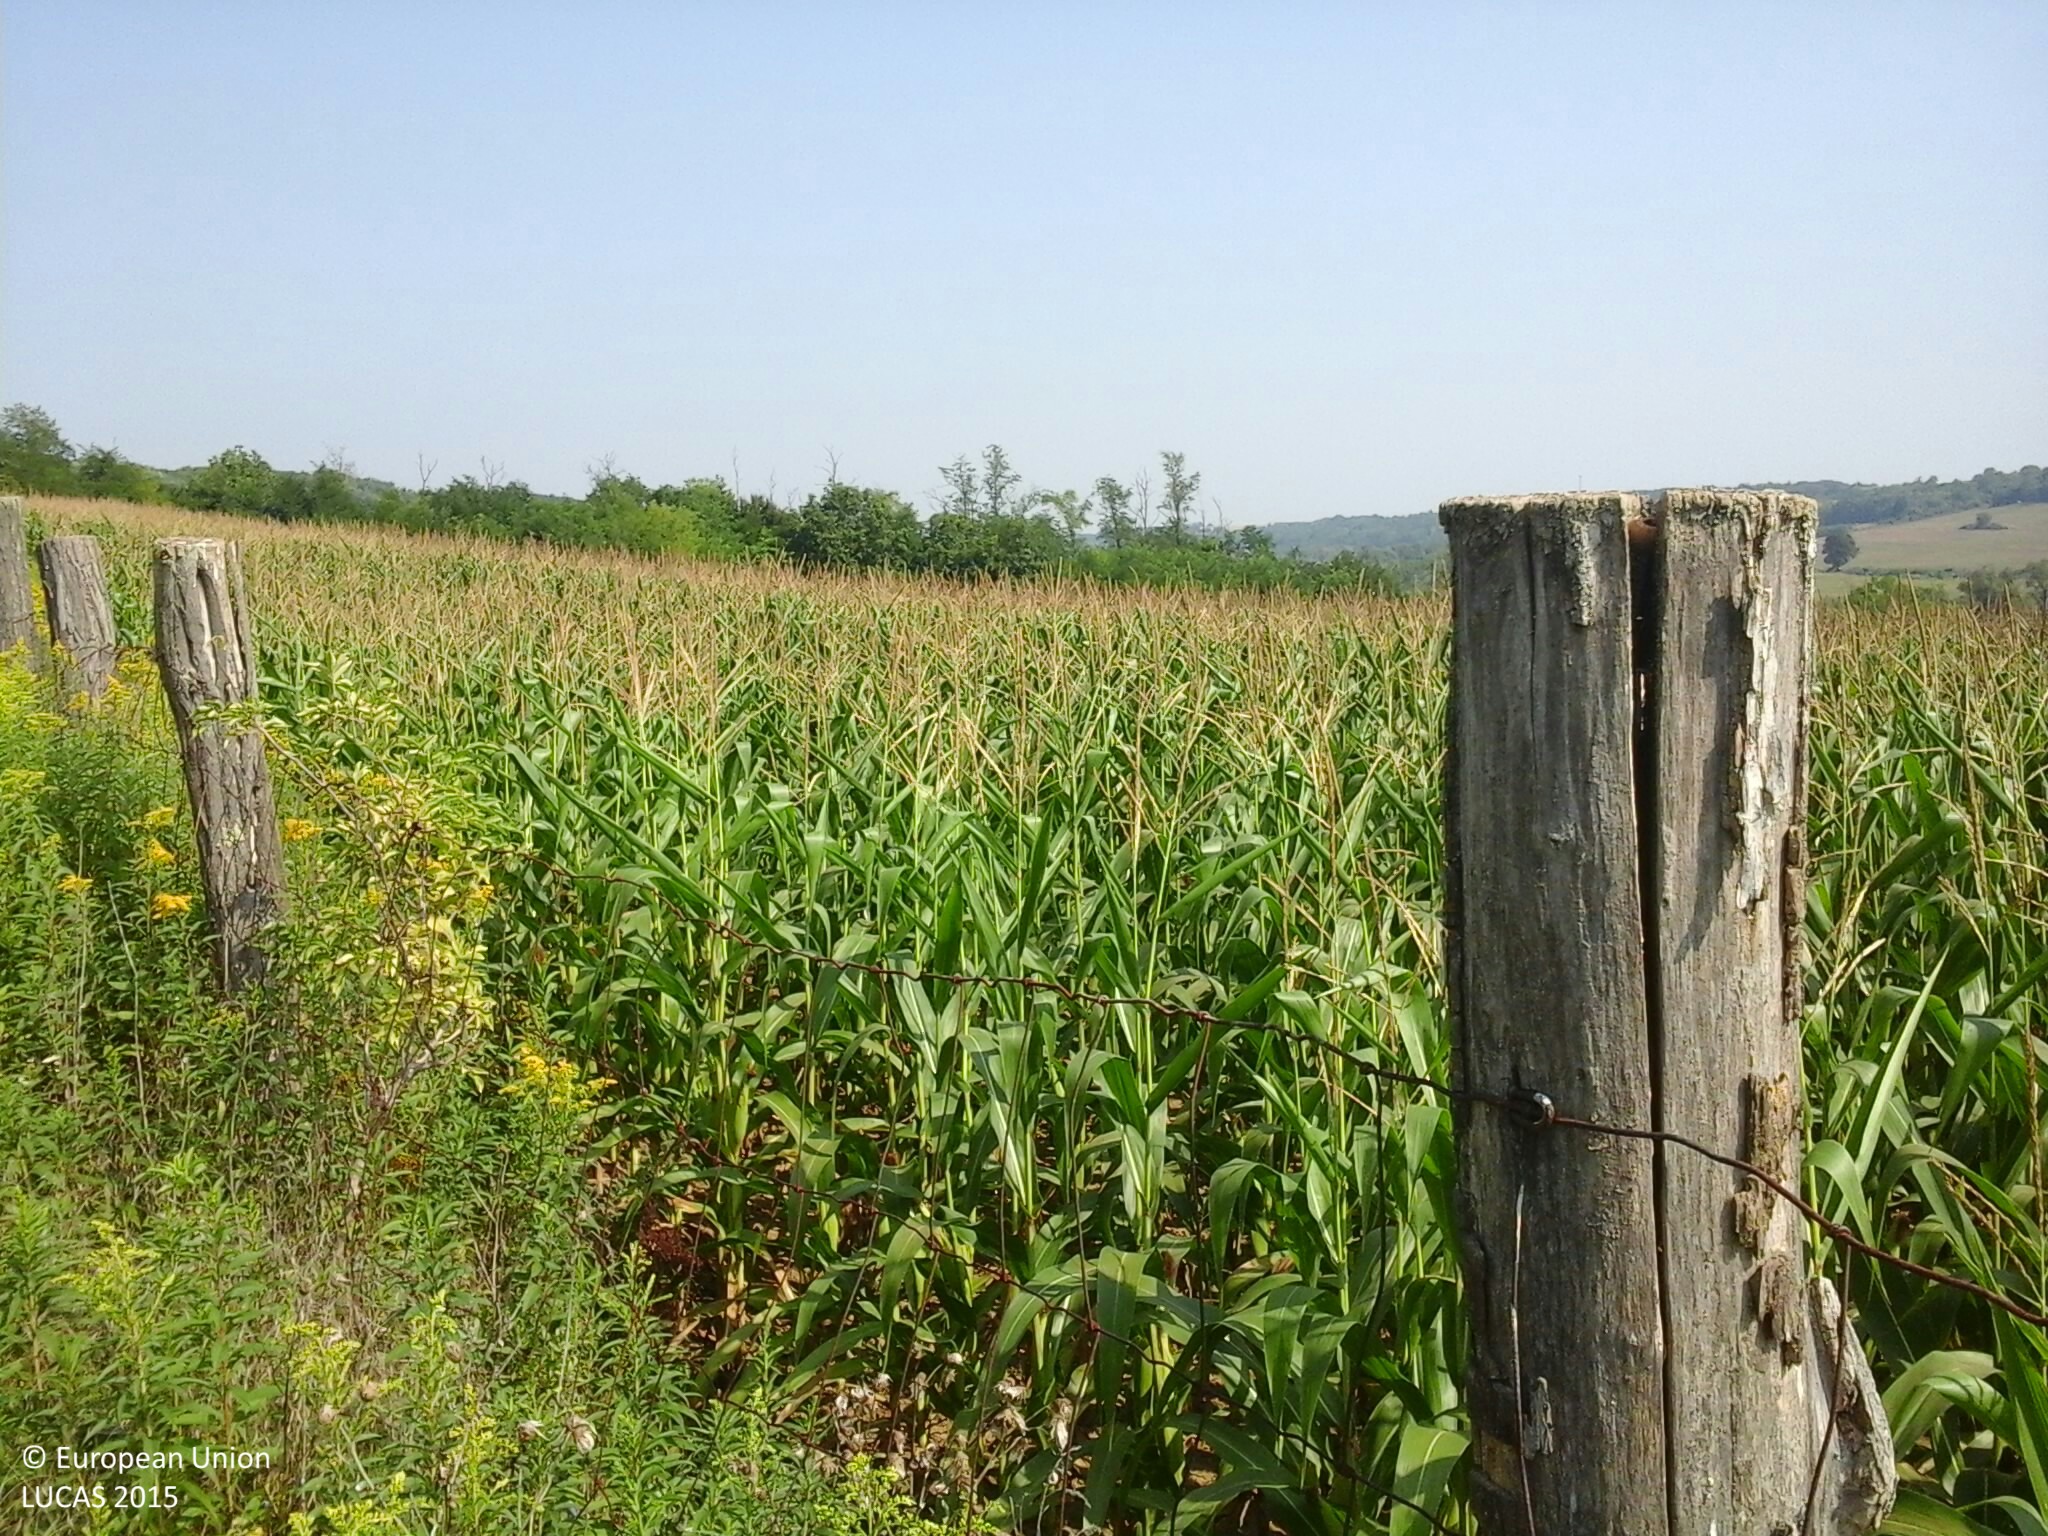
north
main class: Cropland
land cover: Maize
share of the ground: > 75 %
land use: Agriculture (excluding fallow land and kitchen gardens)
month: August
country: HU
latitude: 46.6171
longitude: 17.9338
